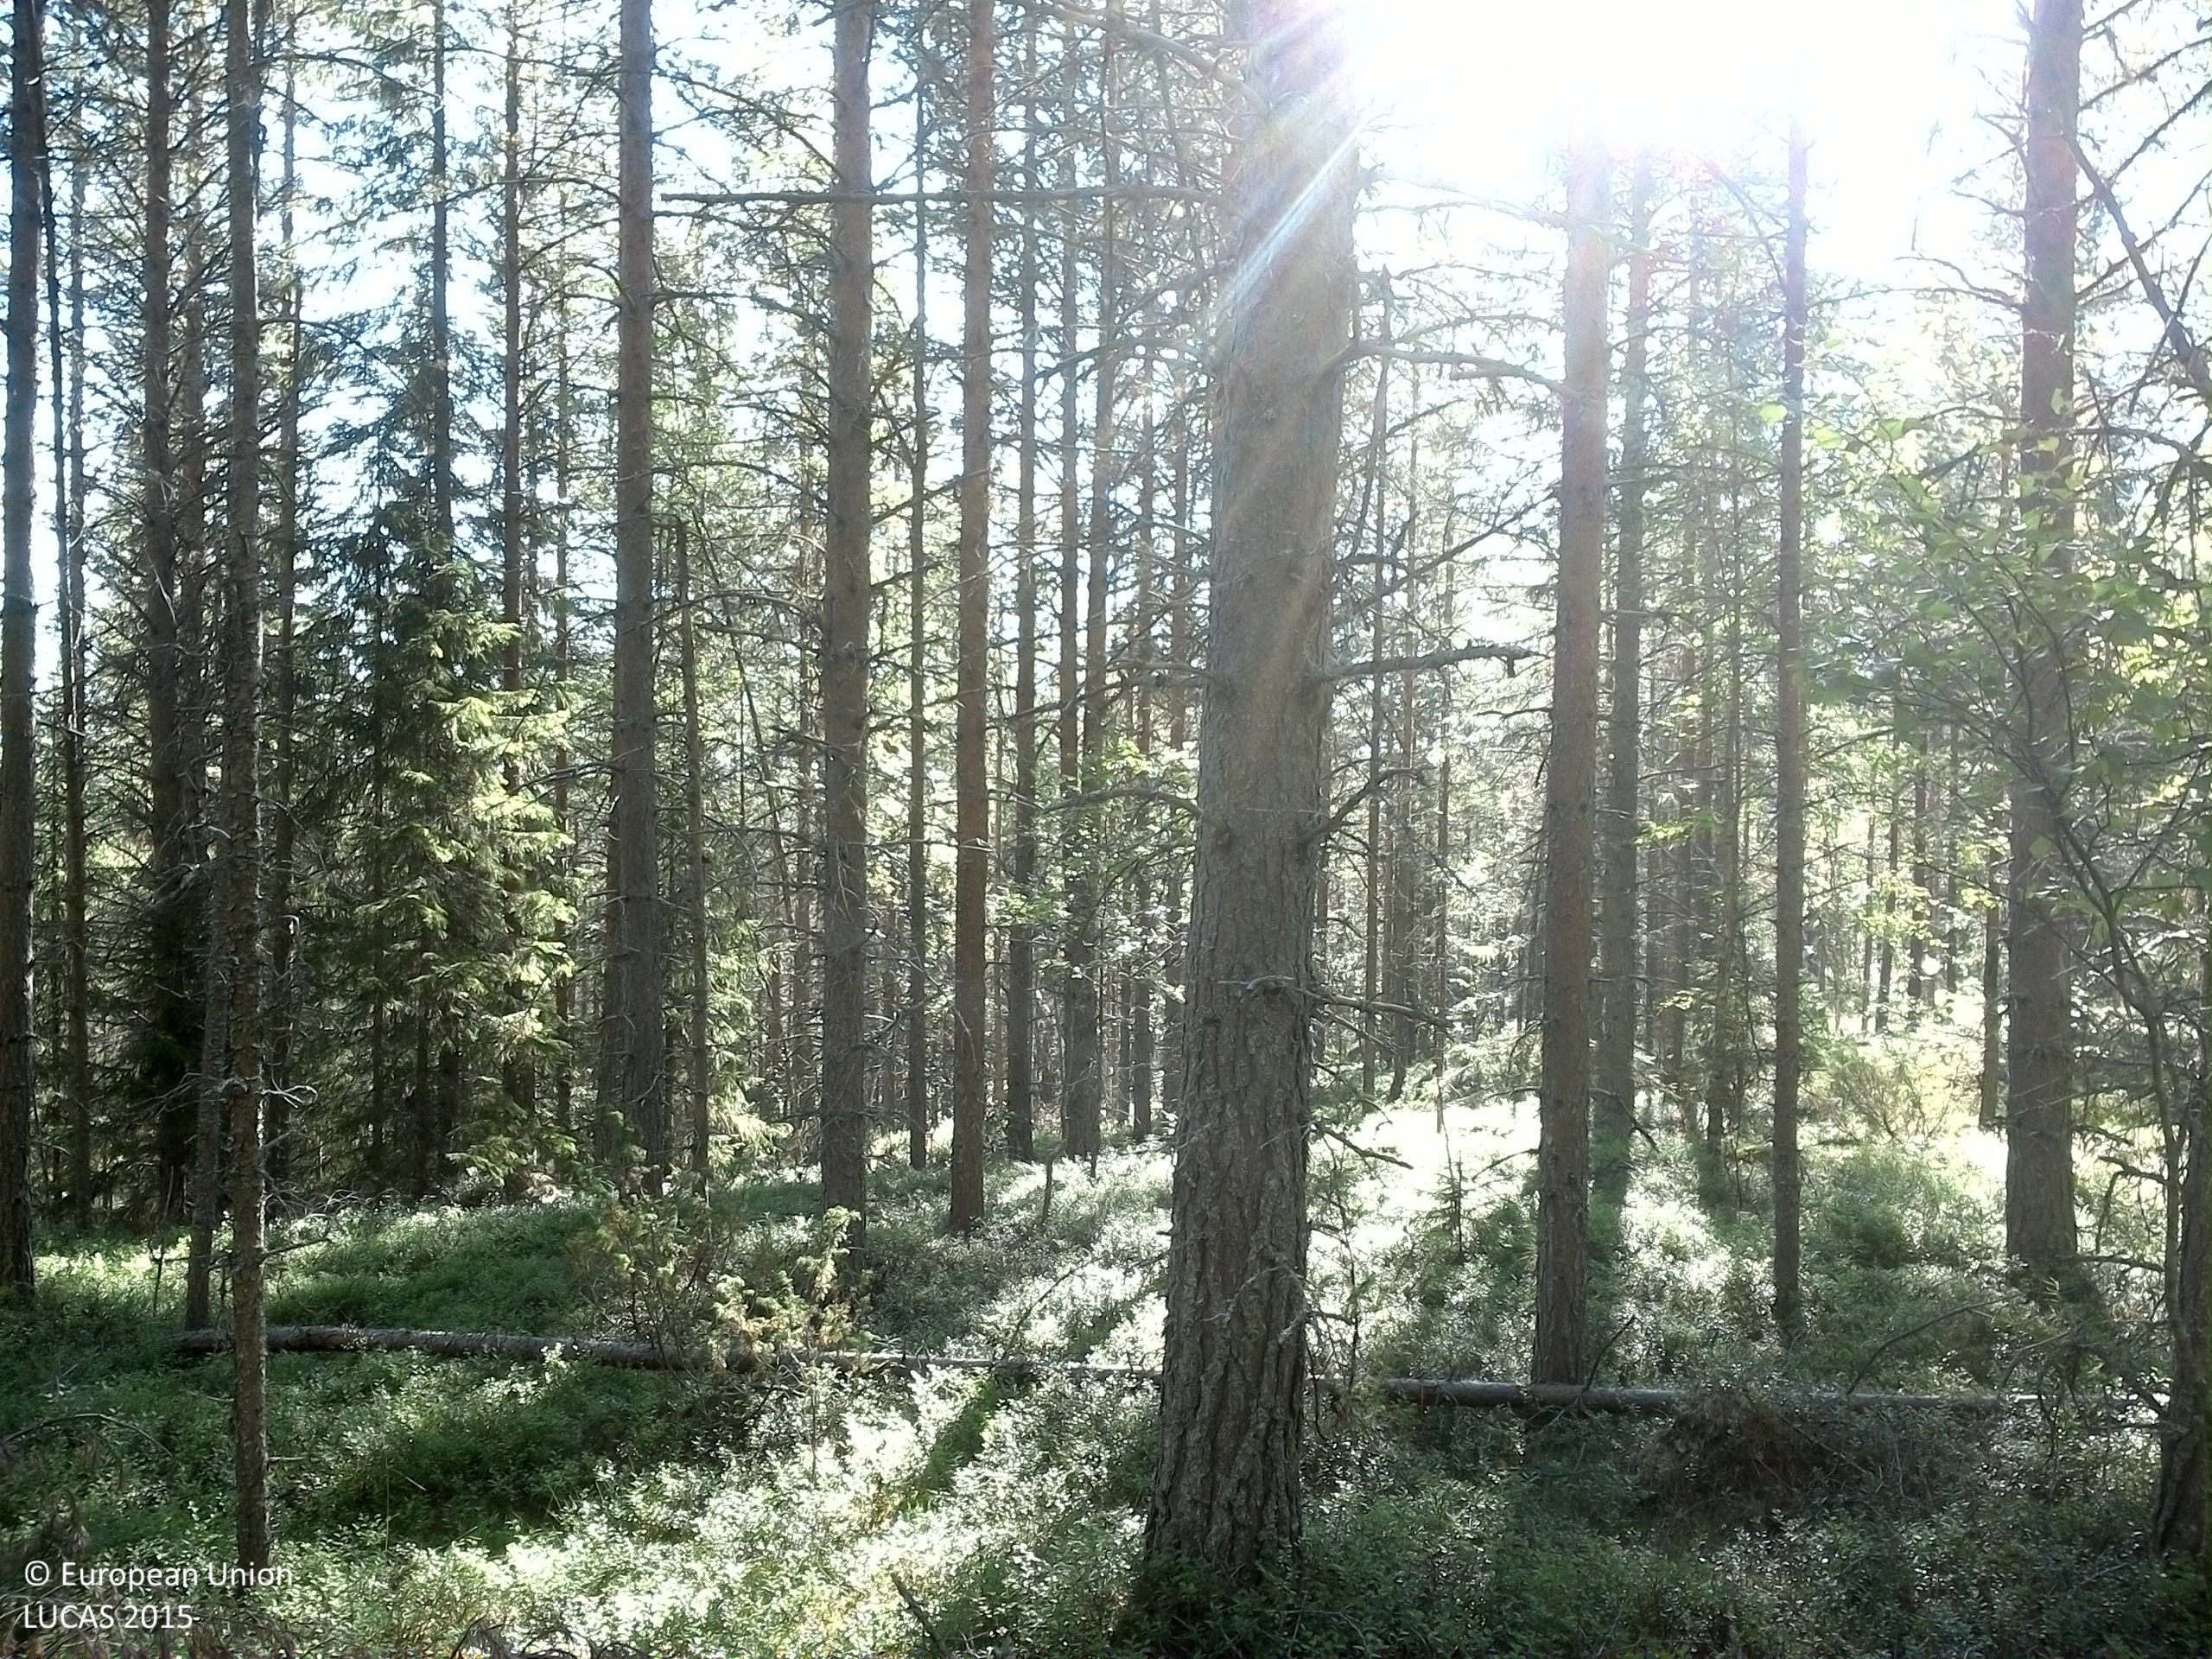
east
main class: Woodland
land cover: Pine dominated coniferous woodland
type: boreal forest
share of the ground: > 75 %
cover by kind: coniferous forest trees 75 %, shrubs 25 %
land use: Forestry
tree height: > 5 m
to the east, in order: Pine dominated coniferous woodland; Pine dominated mixed woodland; Spruce dominated mixed woodland
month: August
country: SE
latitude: 63.6601
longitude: 17.8315
